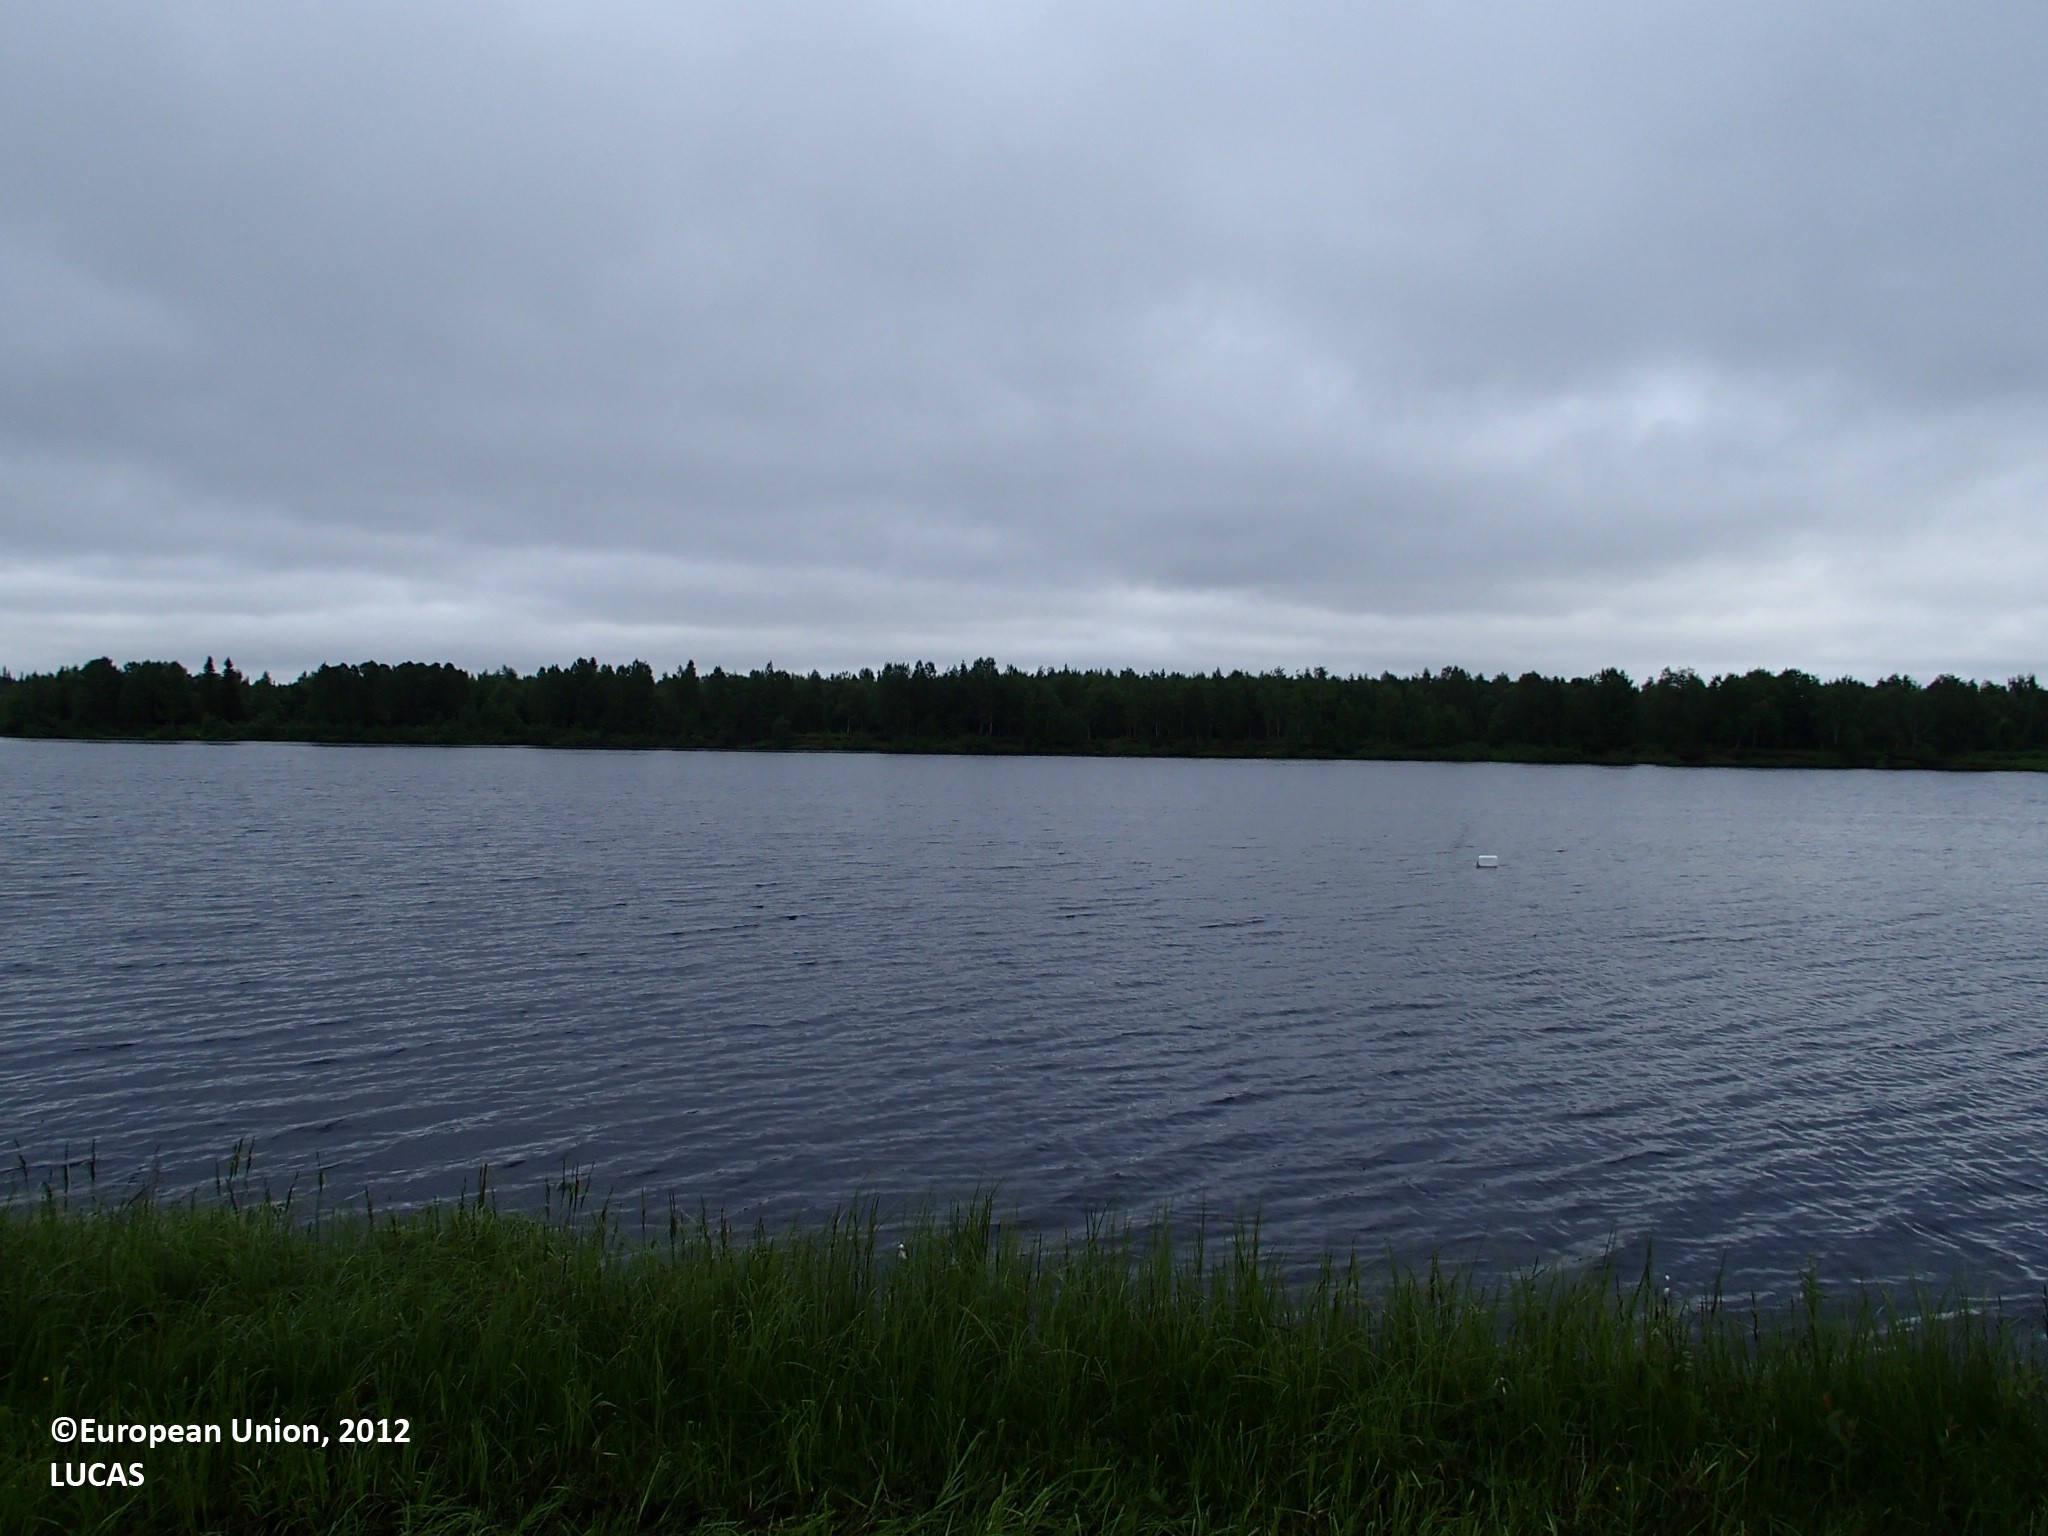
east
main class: Grassland
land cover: Grassland without tree/shrub cover
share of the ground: > 75 %
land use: Amenities, museums, leisure
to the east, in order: Grassland without tree/shrub cover; Inland running water
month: July
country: FI
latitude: 66.9875
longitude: 27.5522
